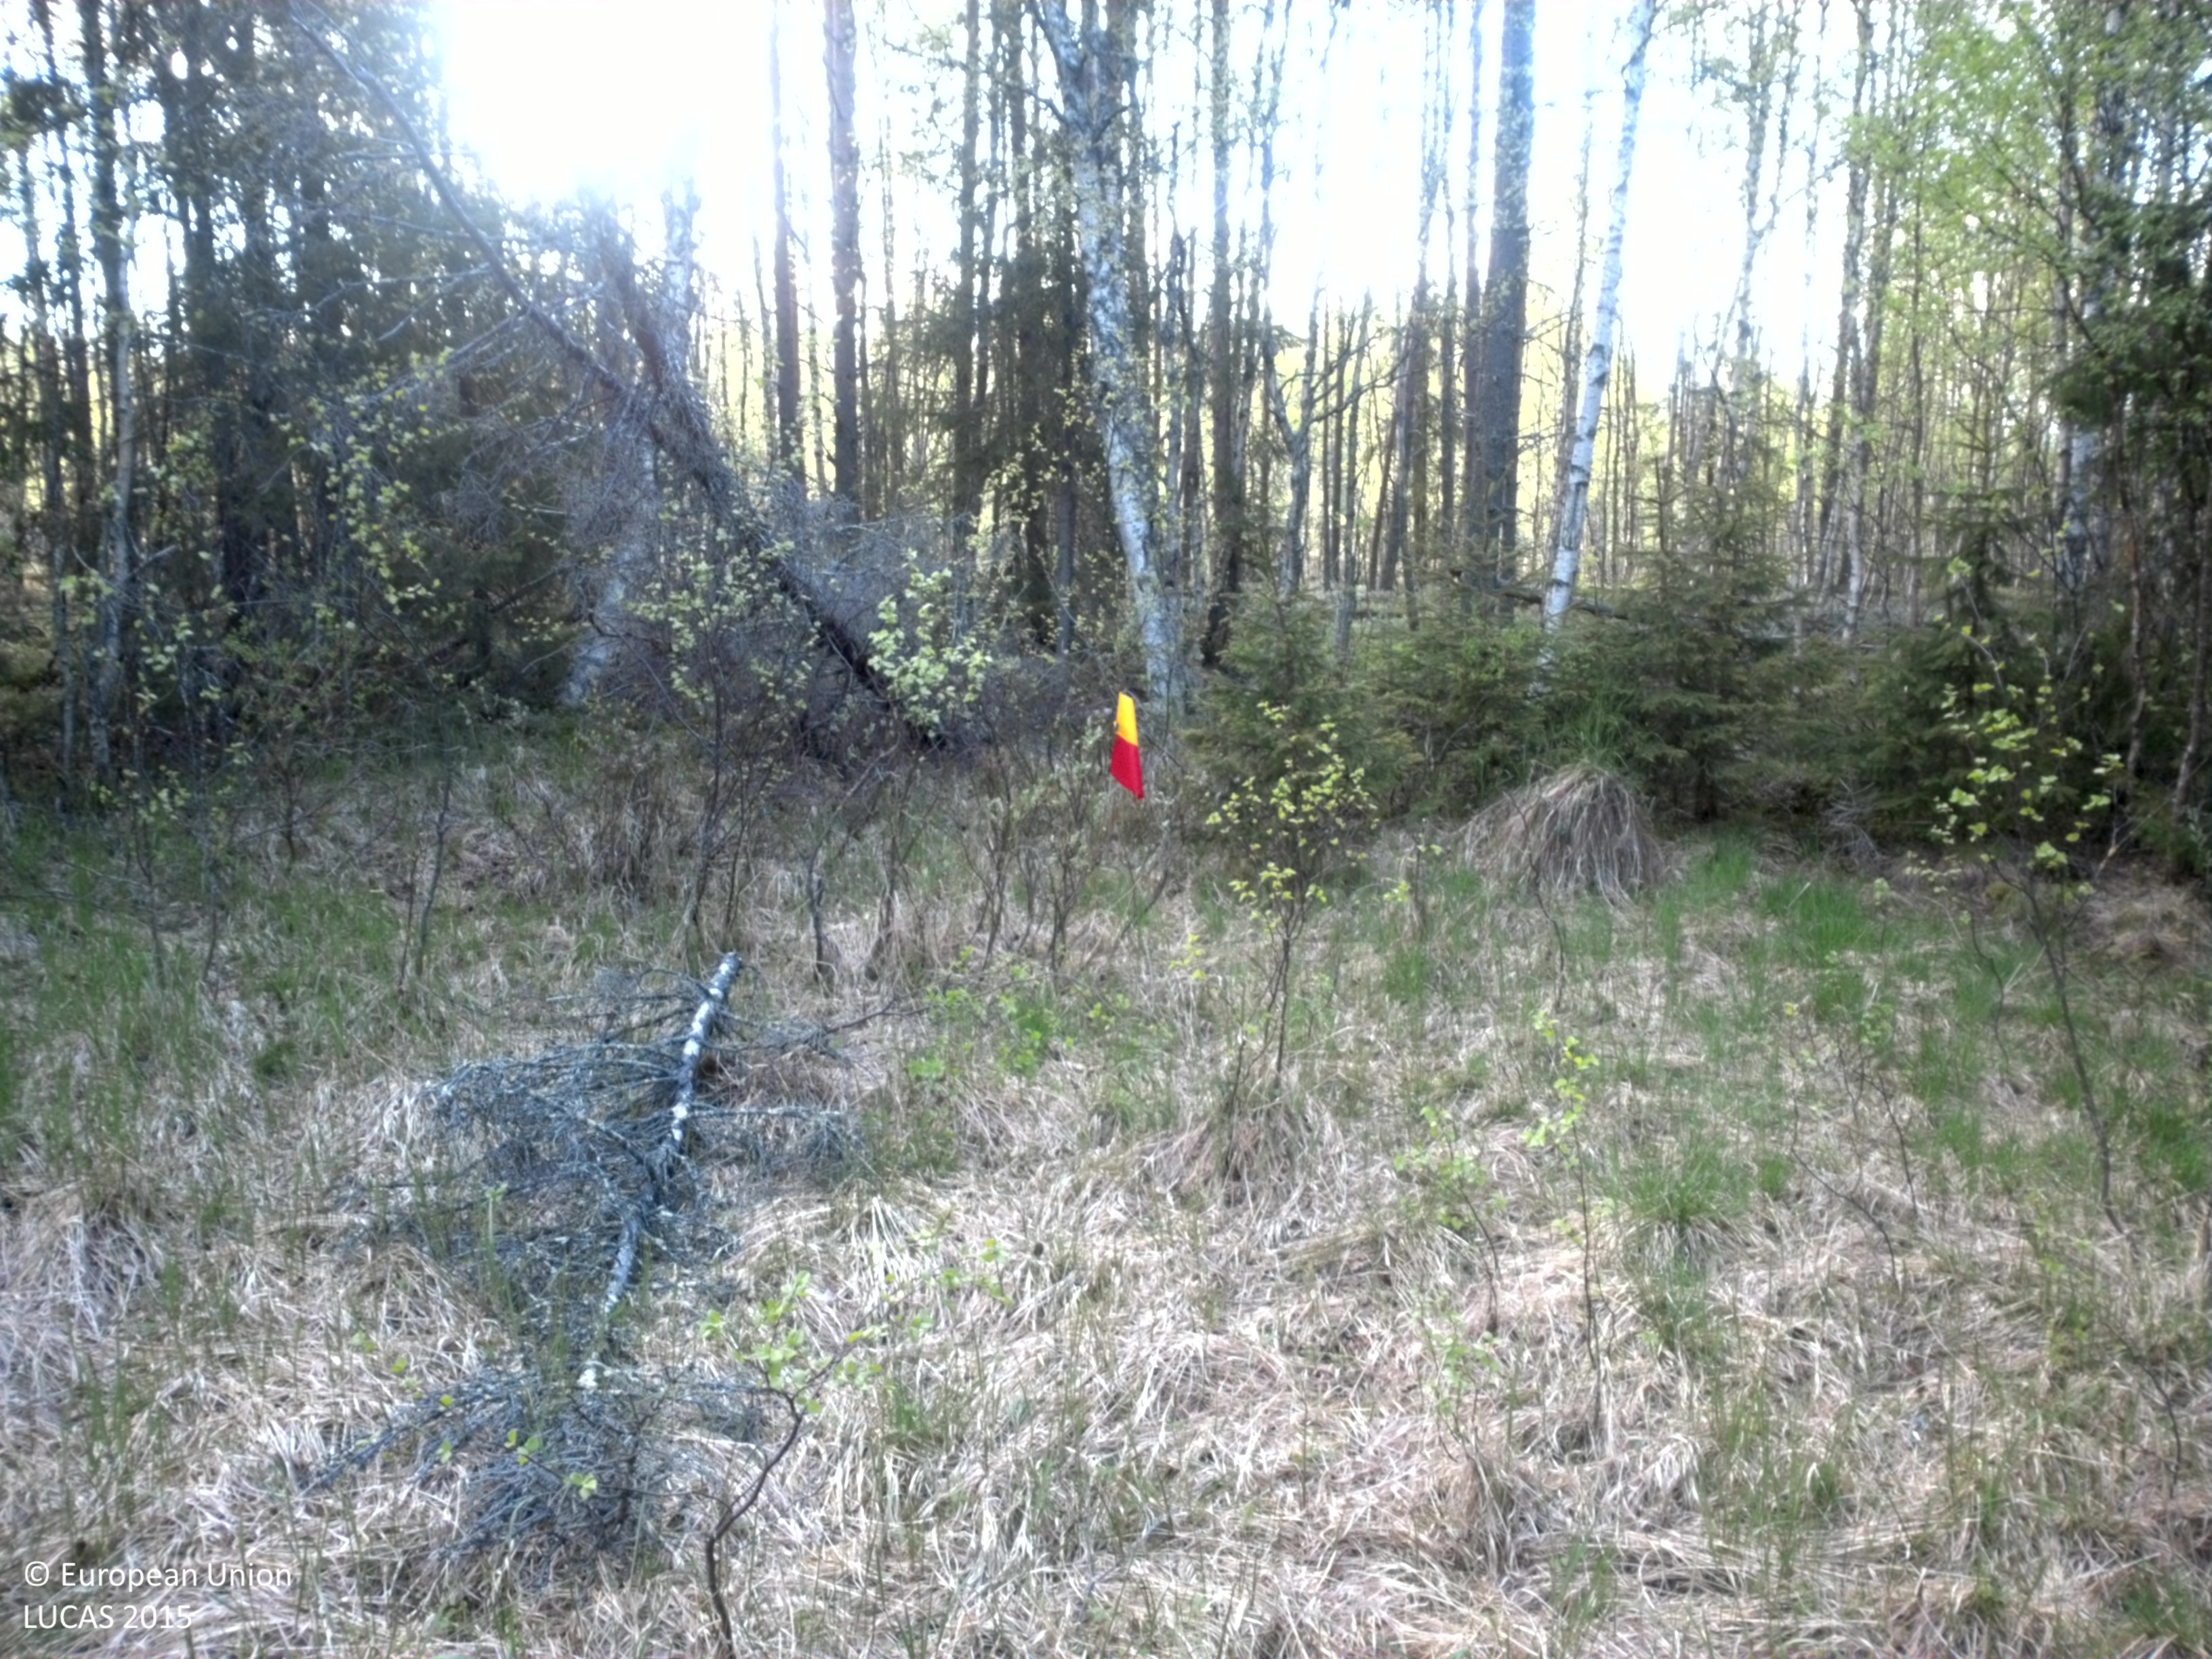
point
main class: Woodland
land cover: Other mixed woodland
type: boreal forest
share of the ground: 25 - 50 %
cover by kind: herbaceous plants 35 %, broadleaved forest trees 30 %, shrubs 20 %, coniferous forest trees 10 %
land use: Forestry
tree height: > 5 m
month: June
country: SE
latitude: 64.2212
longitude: 17.4914
